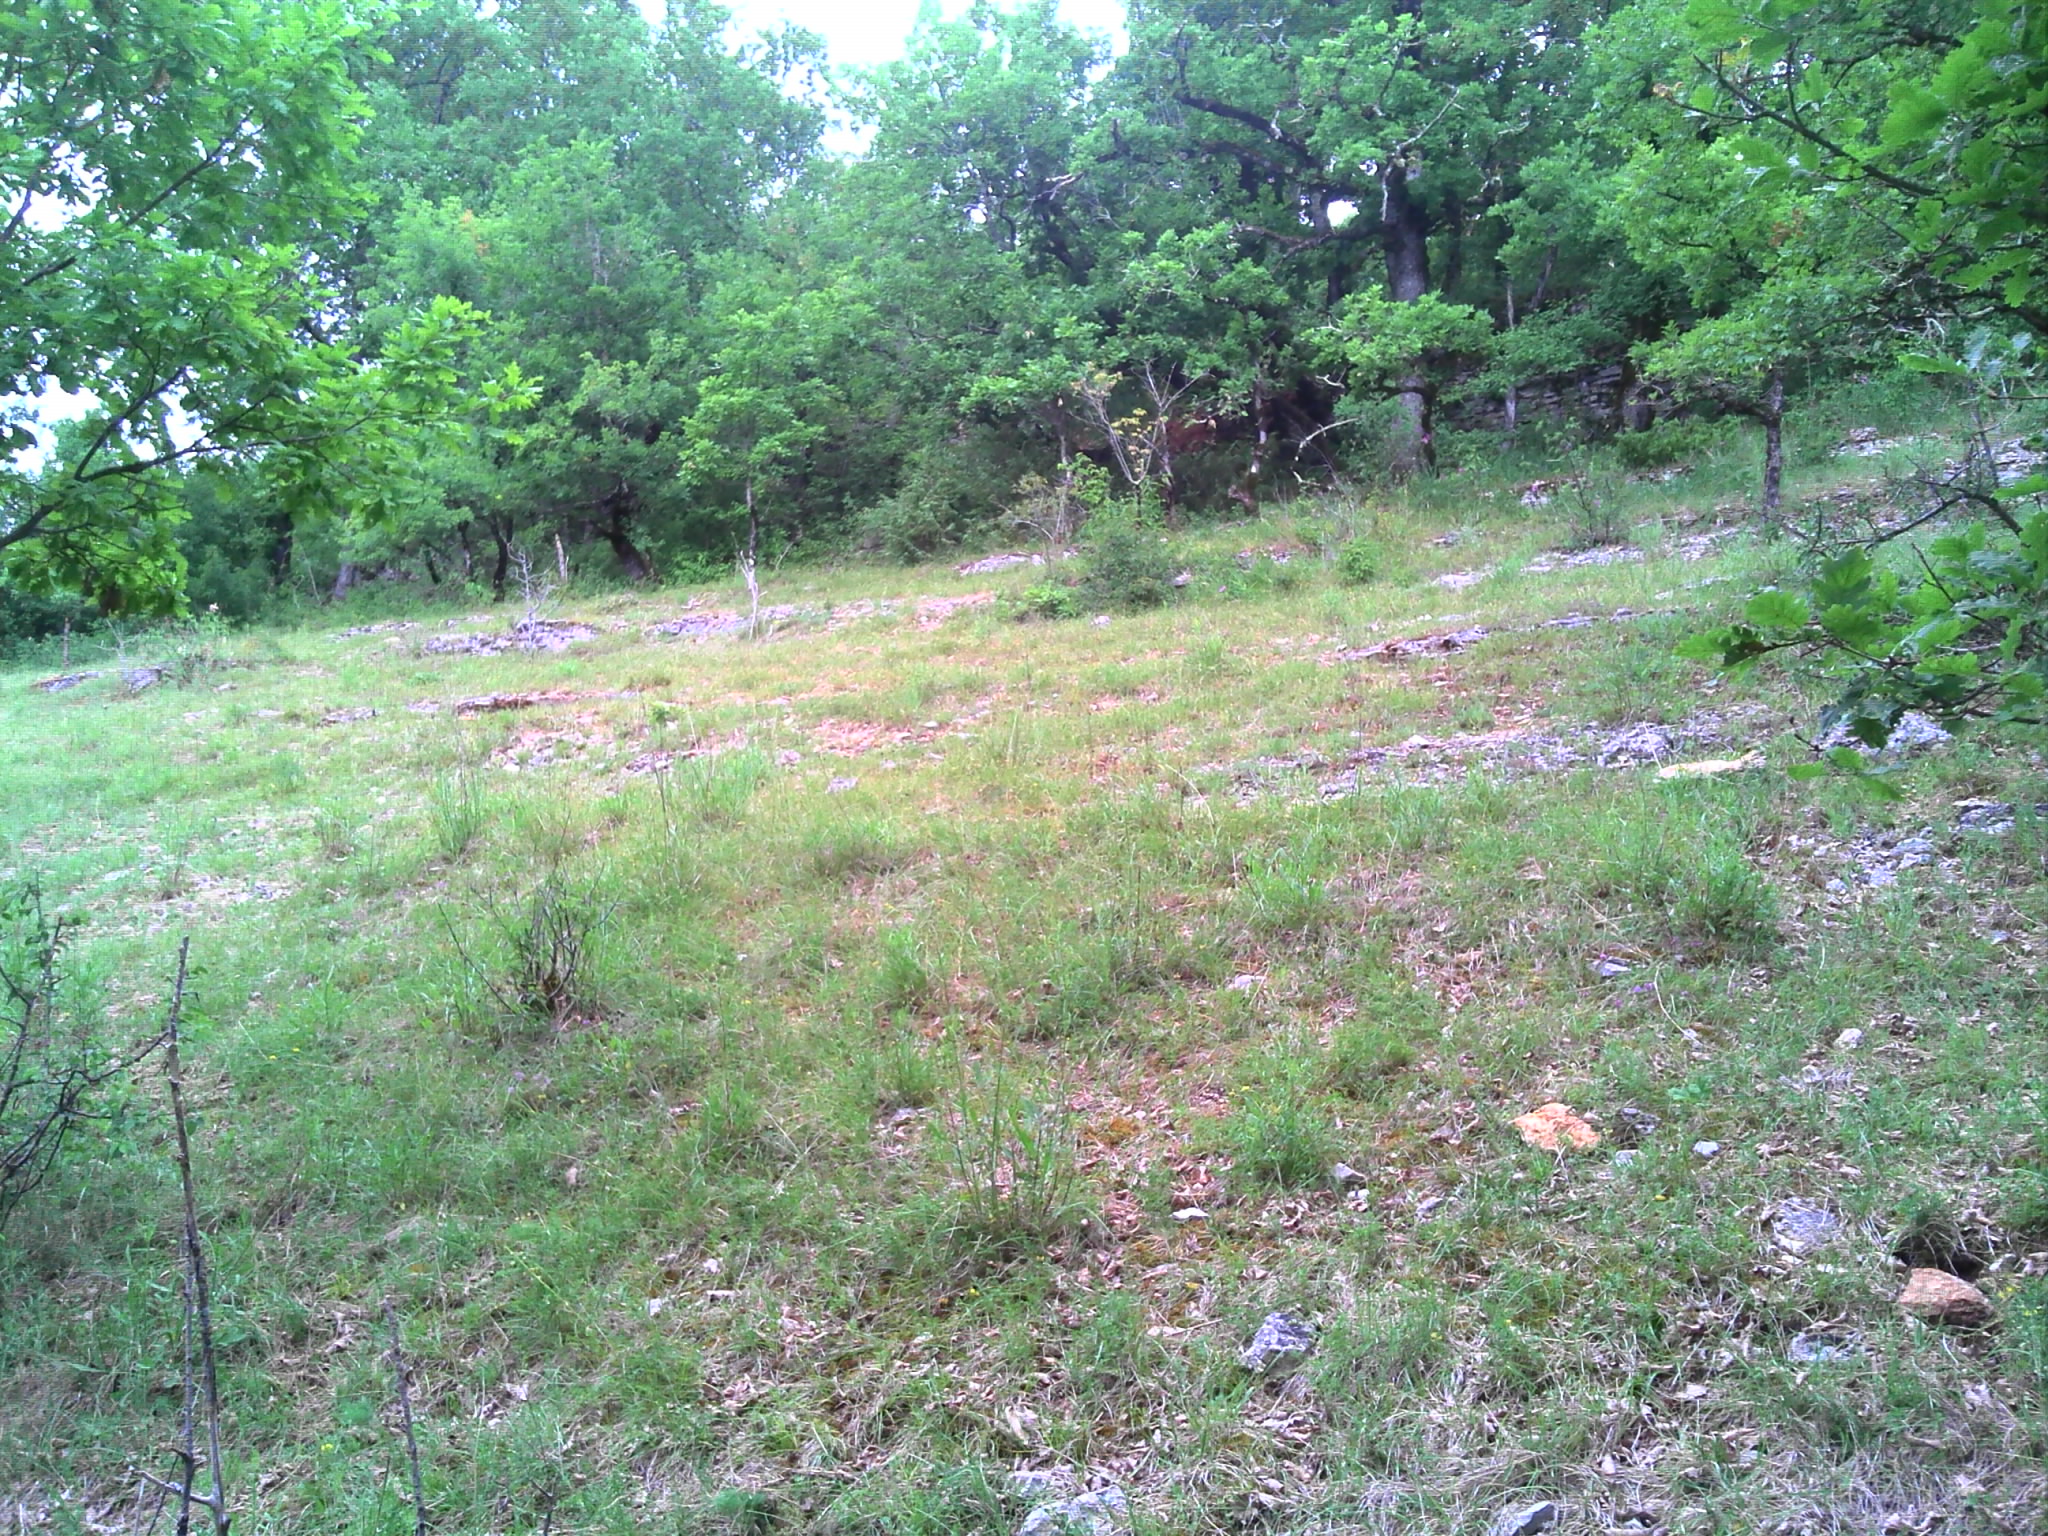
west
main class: Woodland
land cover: Broadleaved woodland
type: thermophilous deciduous forest
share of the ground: 50 - 75 %
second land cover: Grassland without tree/shrub cover
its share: 25 - 50 %
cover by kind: broadleaved forest trees 80 %, herbaceous plants 20 %
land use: Forestry
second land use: Agriculture (excluding fallow land and kitchen gardens)
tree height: > 5 m
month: June
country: FR
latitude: 44.4280
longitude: 1.8478
